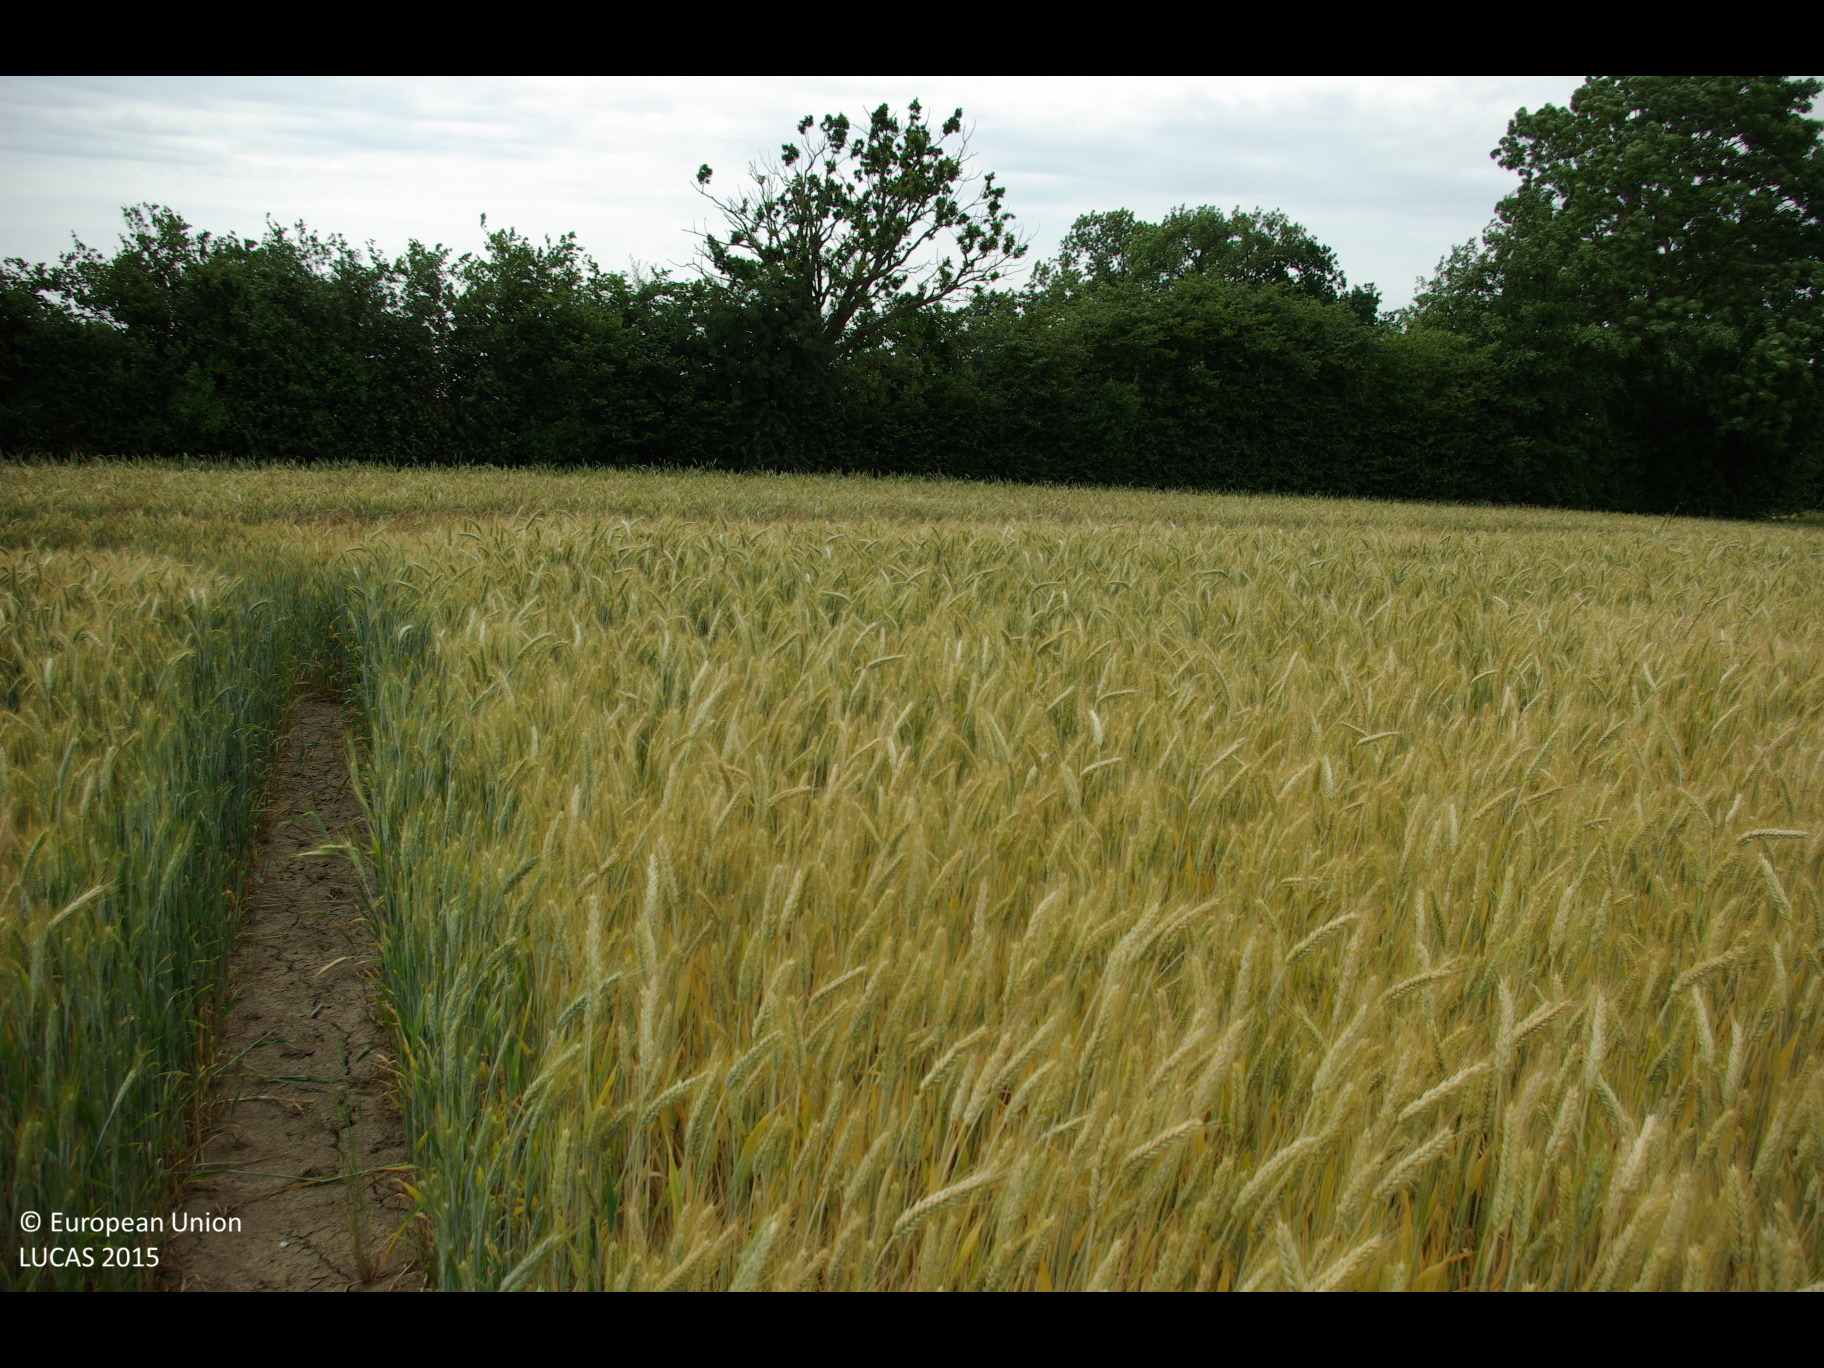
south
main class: Cropland
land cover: Triticale
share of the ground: > 75 %
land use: Agriculture (excluding fallow land and kitchen gardens)
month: July
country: DE
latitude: 54.7498
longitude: 9.9224
